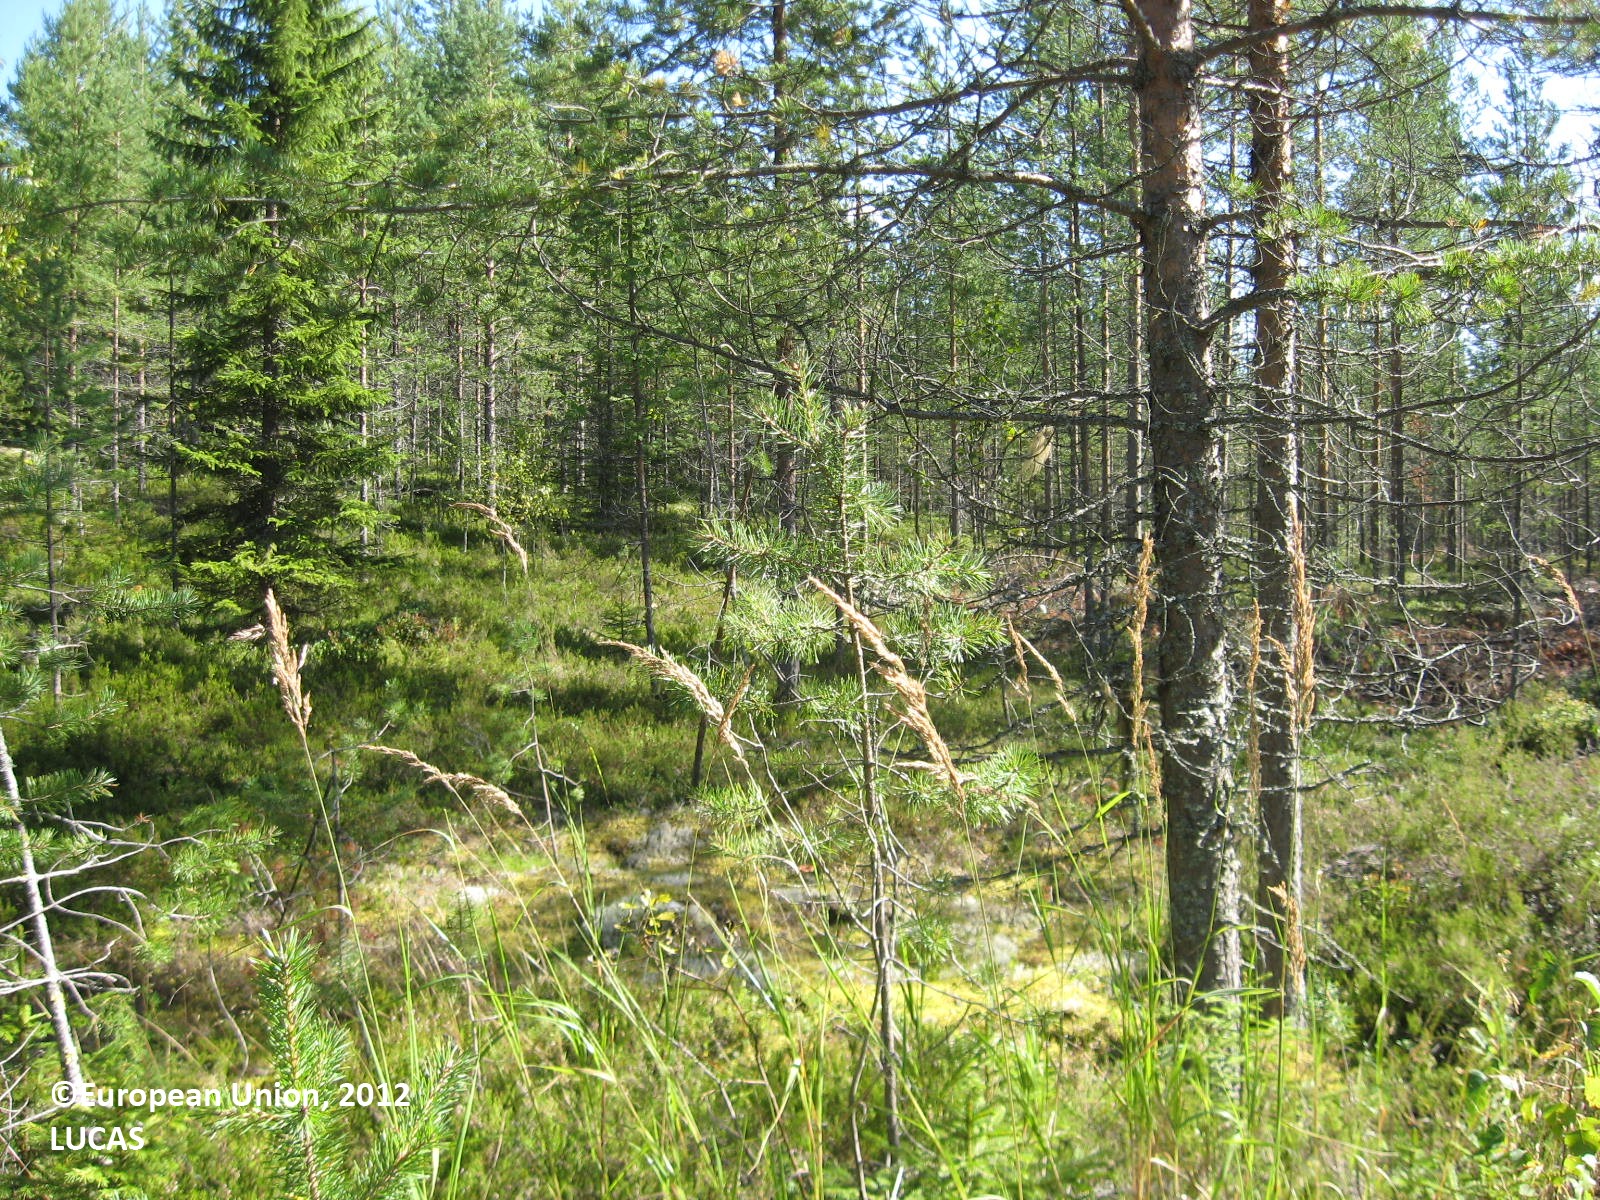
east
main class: Woodland
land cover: Pine dominated coniferous woodland
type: boreal forest
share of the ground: > 75 %
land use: Forestry
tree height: > 5 m
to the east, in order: Pine dominated coniferous woodland
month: August
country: FI
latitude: 63.6475
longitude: 29.8458
